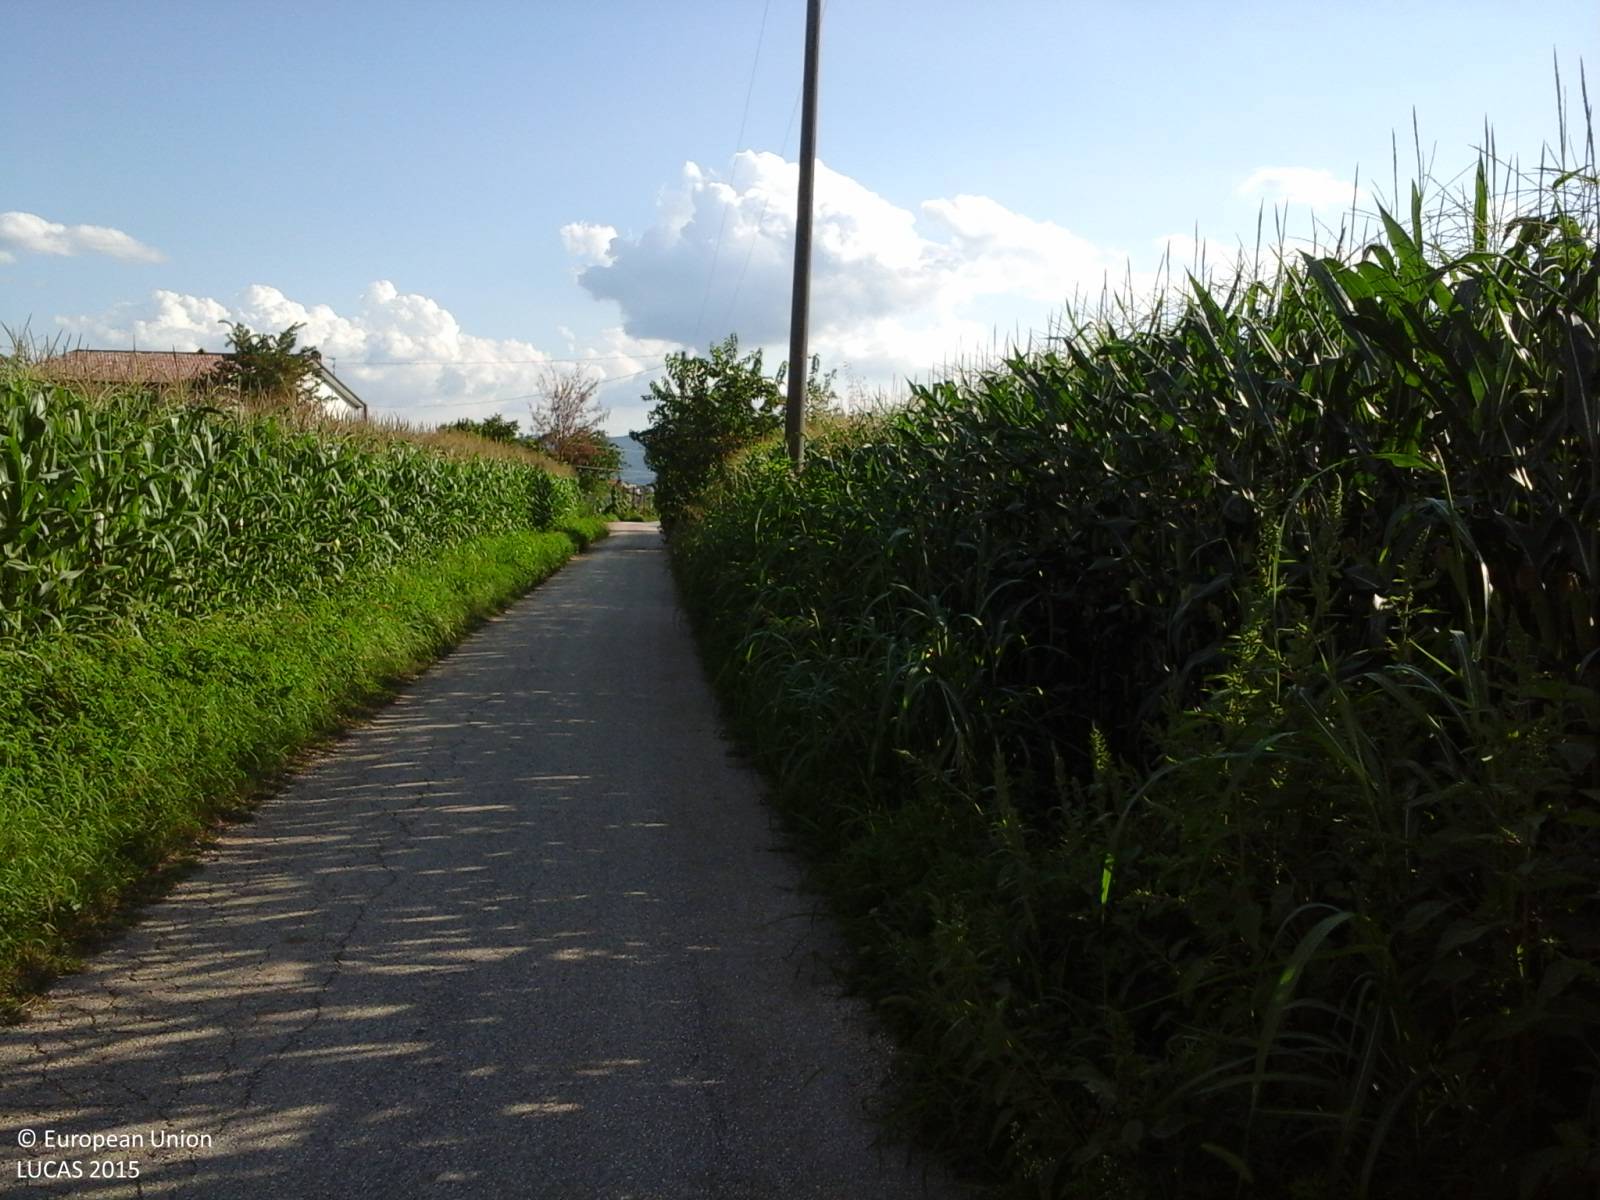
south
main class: Cropland
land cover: Maize
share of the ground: > 75 %
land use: Agriculture (excluding fallow land and kitchen gardens)
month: August
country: IT
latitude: 41.3304
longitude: 14.3448
